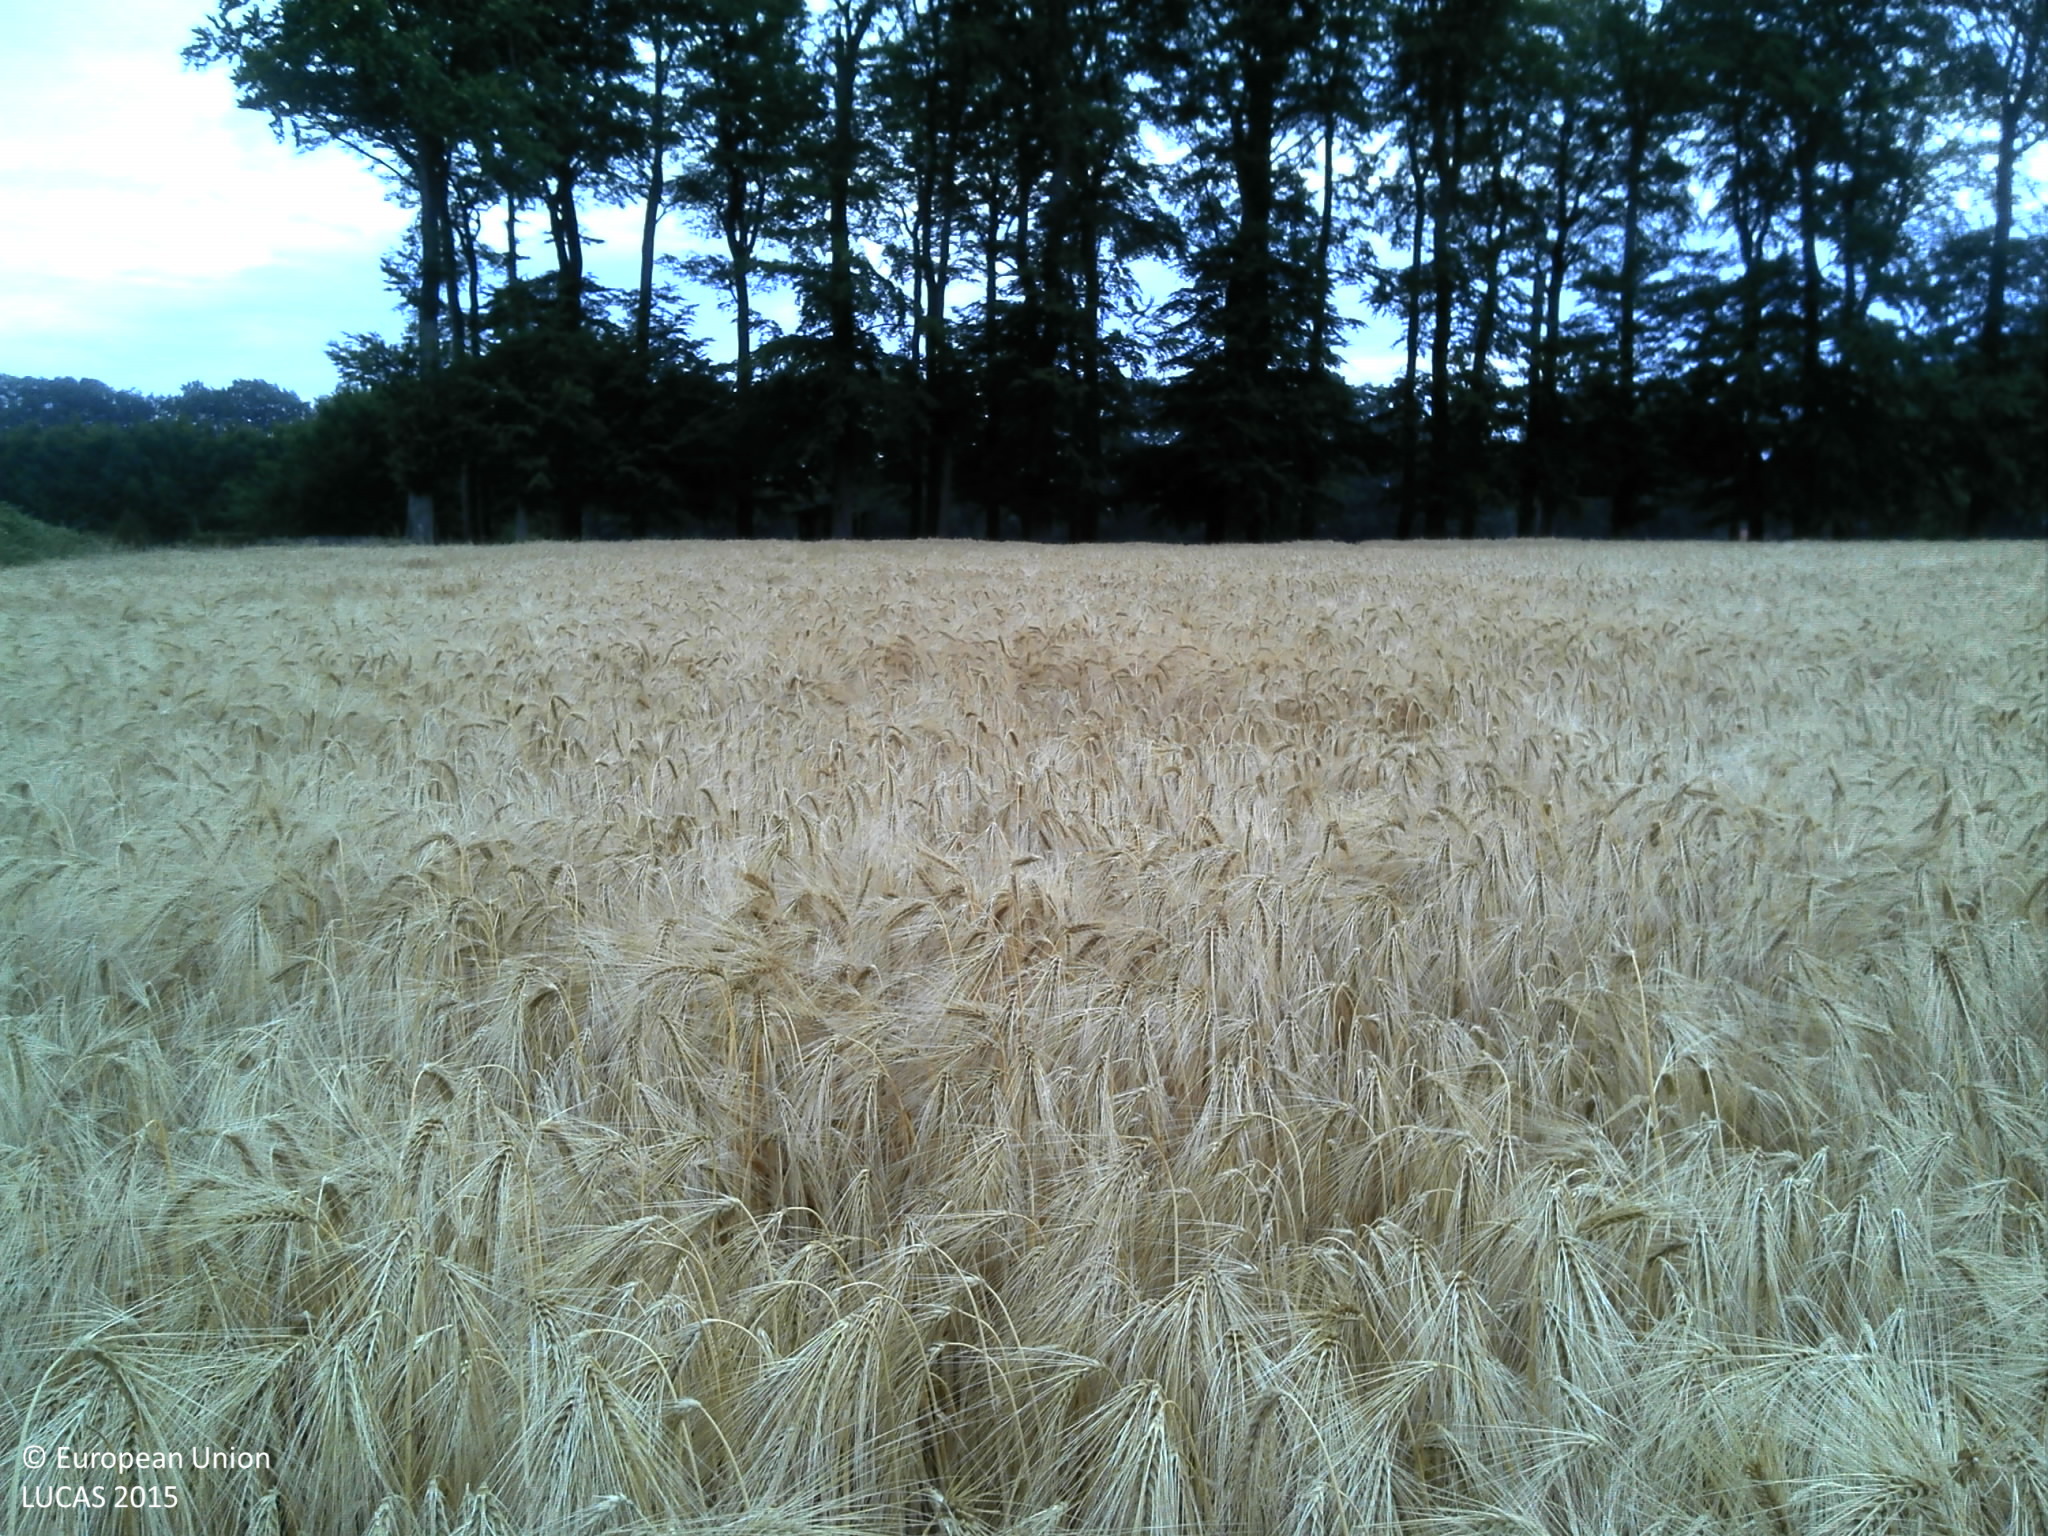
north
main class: Cropland
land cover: Barley
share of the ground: > 75 %
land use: Agriculture (excluding fallow land and kitchen gardens)
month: July
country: FR
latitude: 49.8999
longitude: 0.9975
